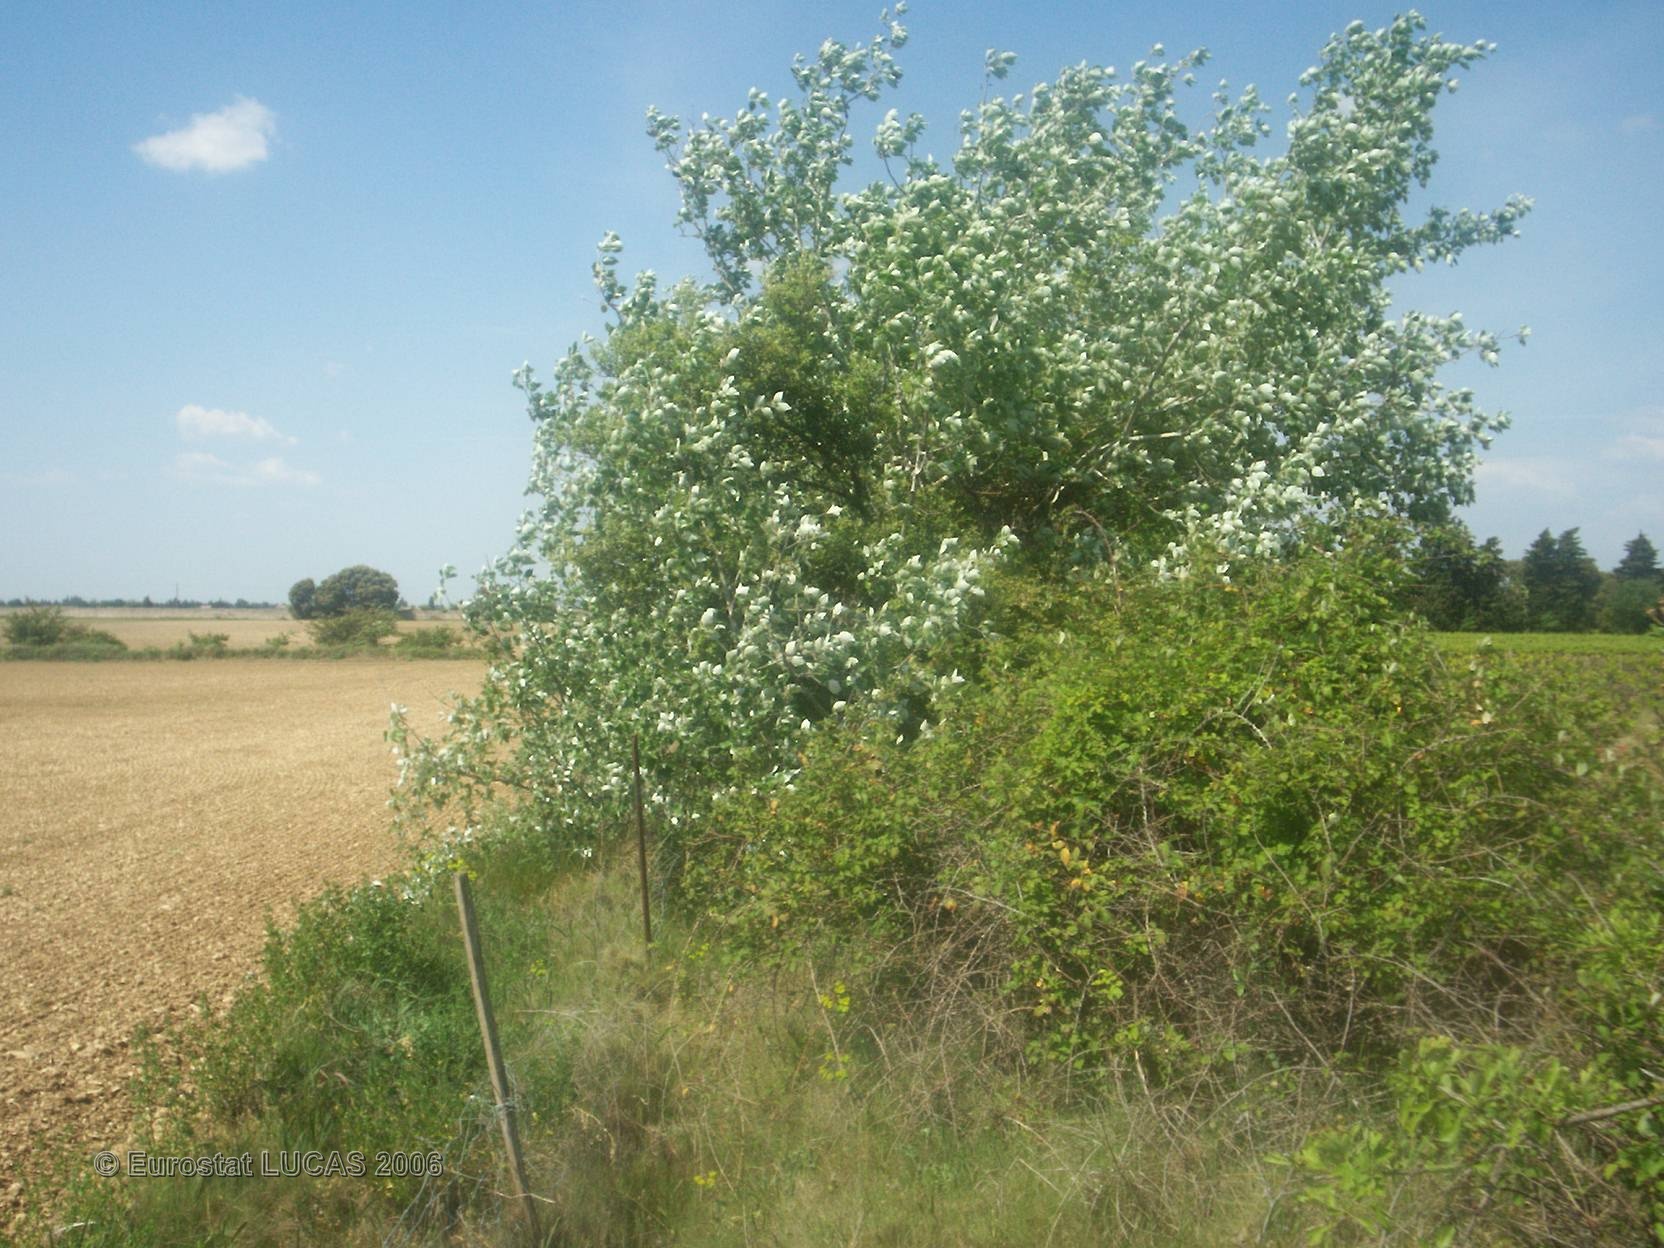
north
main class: Grassland
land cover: Grassland without tree/shrub cover
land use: Agriculture (excluding fallow land and kitchen gardens)
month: June
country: FR
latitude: 44.1371
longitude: 4.9456
